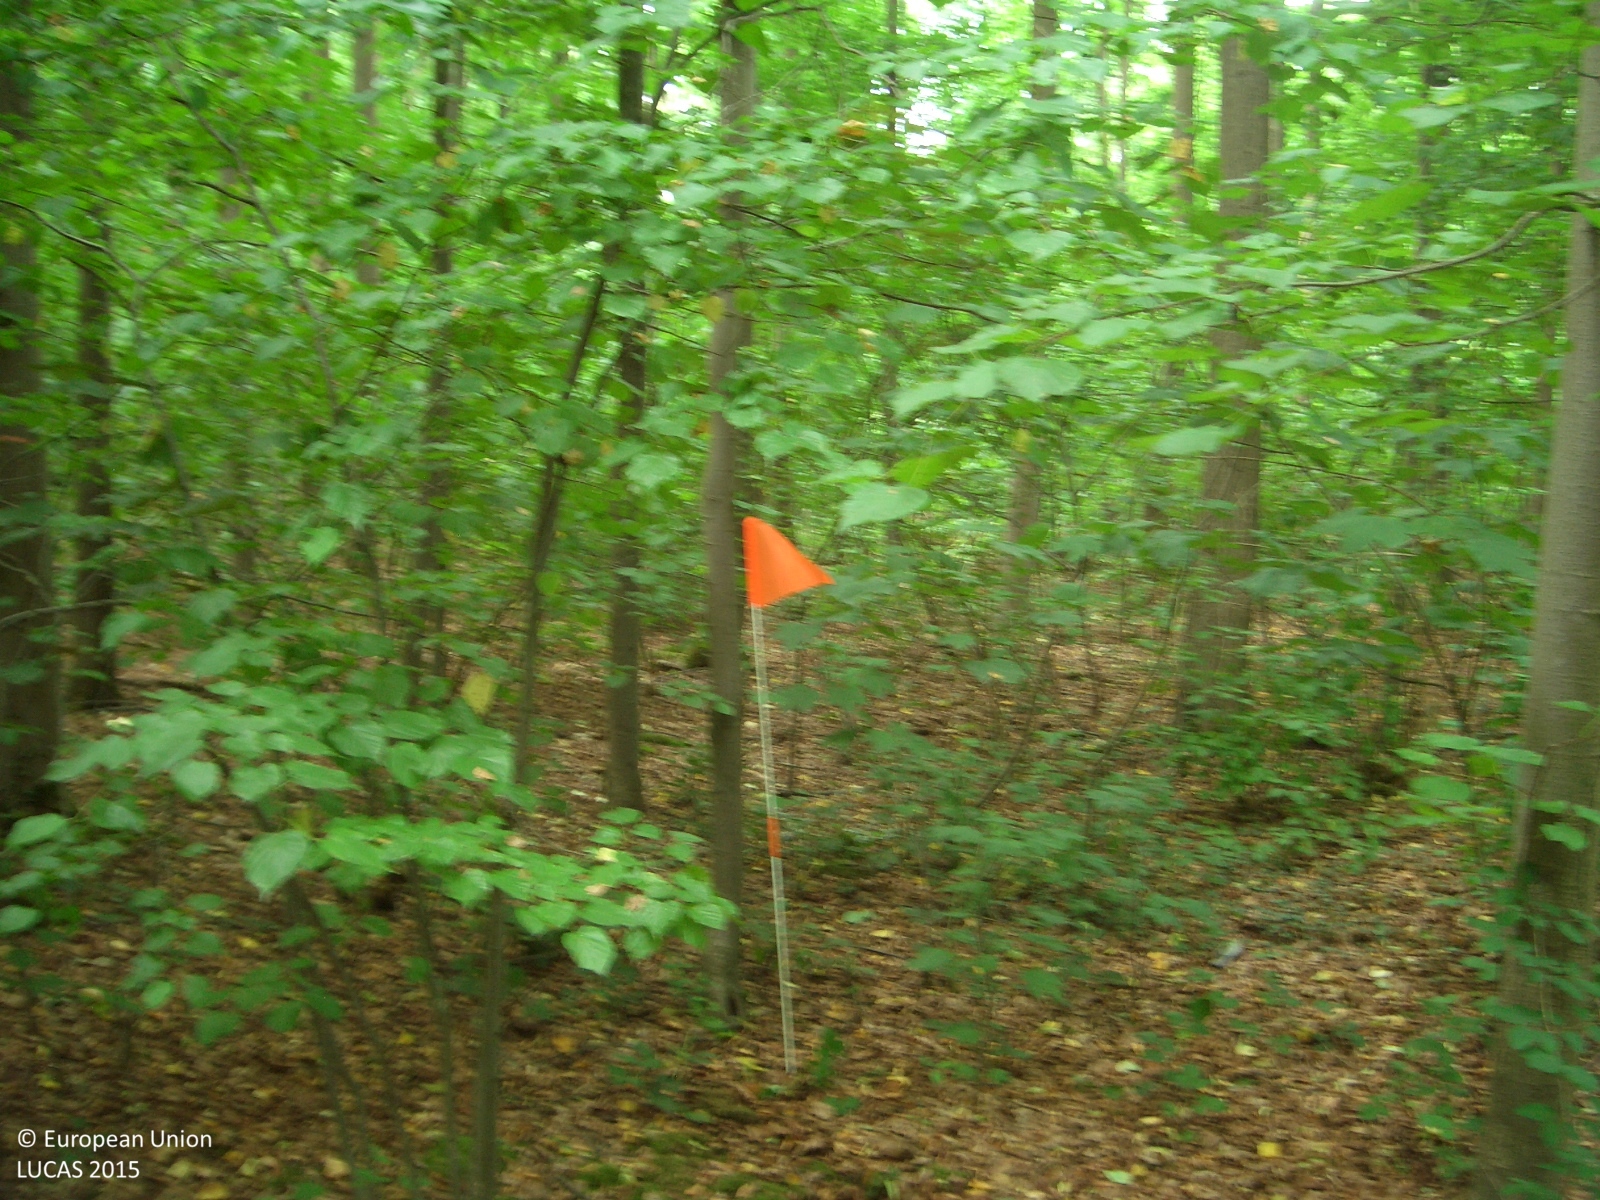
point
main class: Woodland
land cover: Broadleaved woodland
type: mesophytic deciduous forest
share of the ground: > 75 %
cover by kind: broadleaved forest trees 95 %, unconsolidated bare surface 5 %
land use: Forestry
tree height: > 5 m
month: June
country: DE
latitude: 50.9918
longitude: 7.0508
